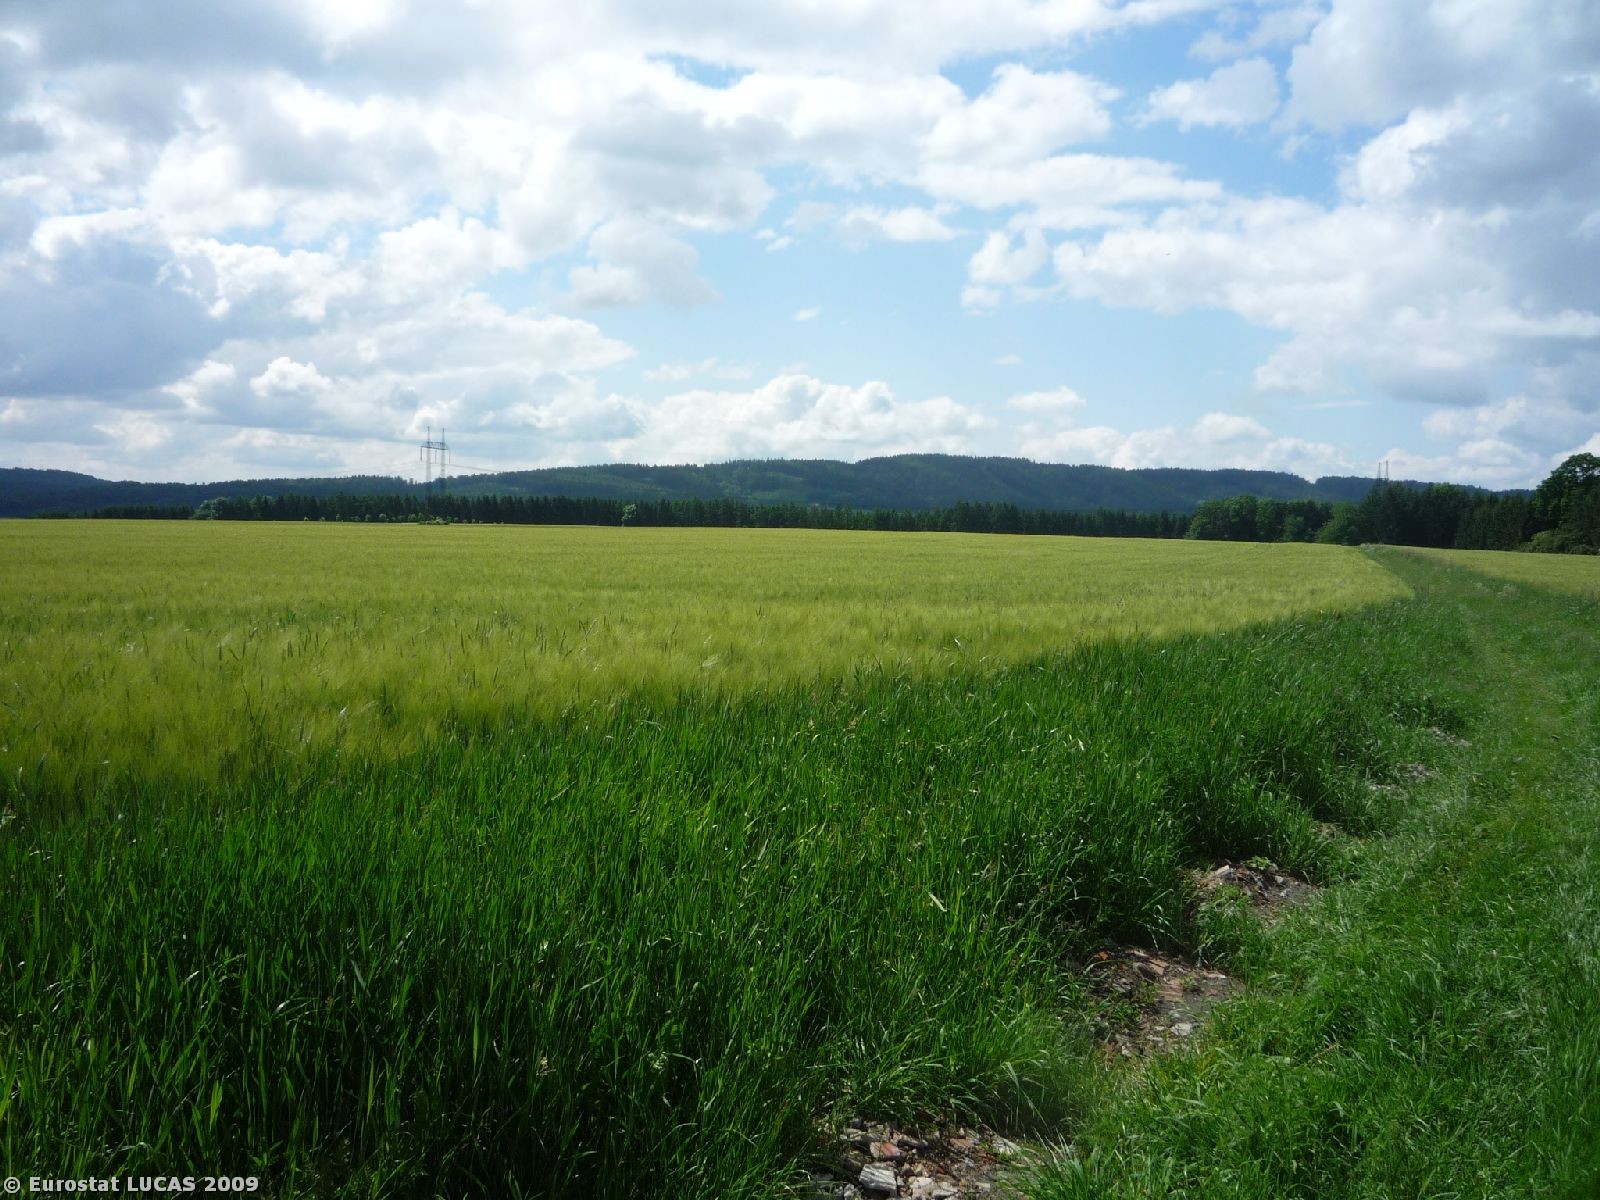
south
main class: Cropland
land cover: Barley
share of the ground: > 75 %
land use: Agriculture (excluding fallow land and kitchen gardens)
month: June
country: CZ
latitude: 50.4283
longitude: 15.5365
